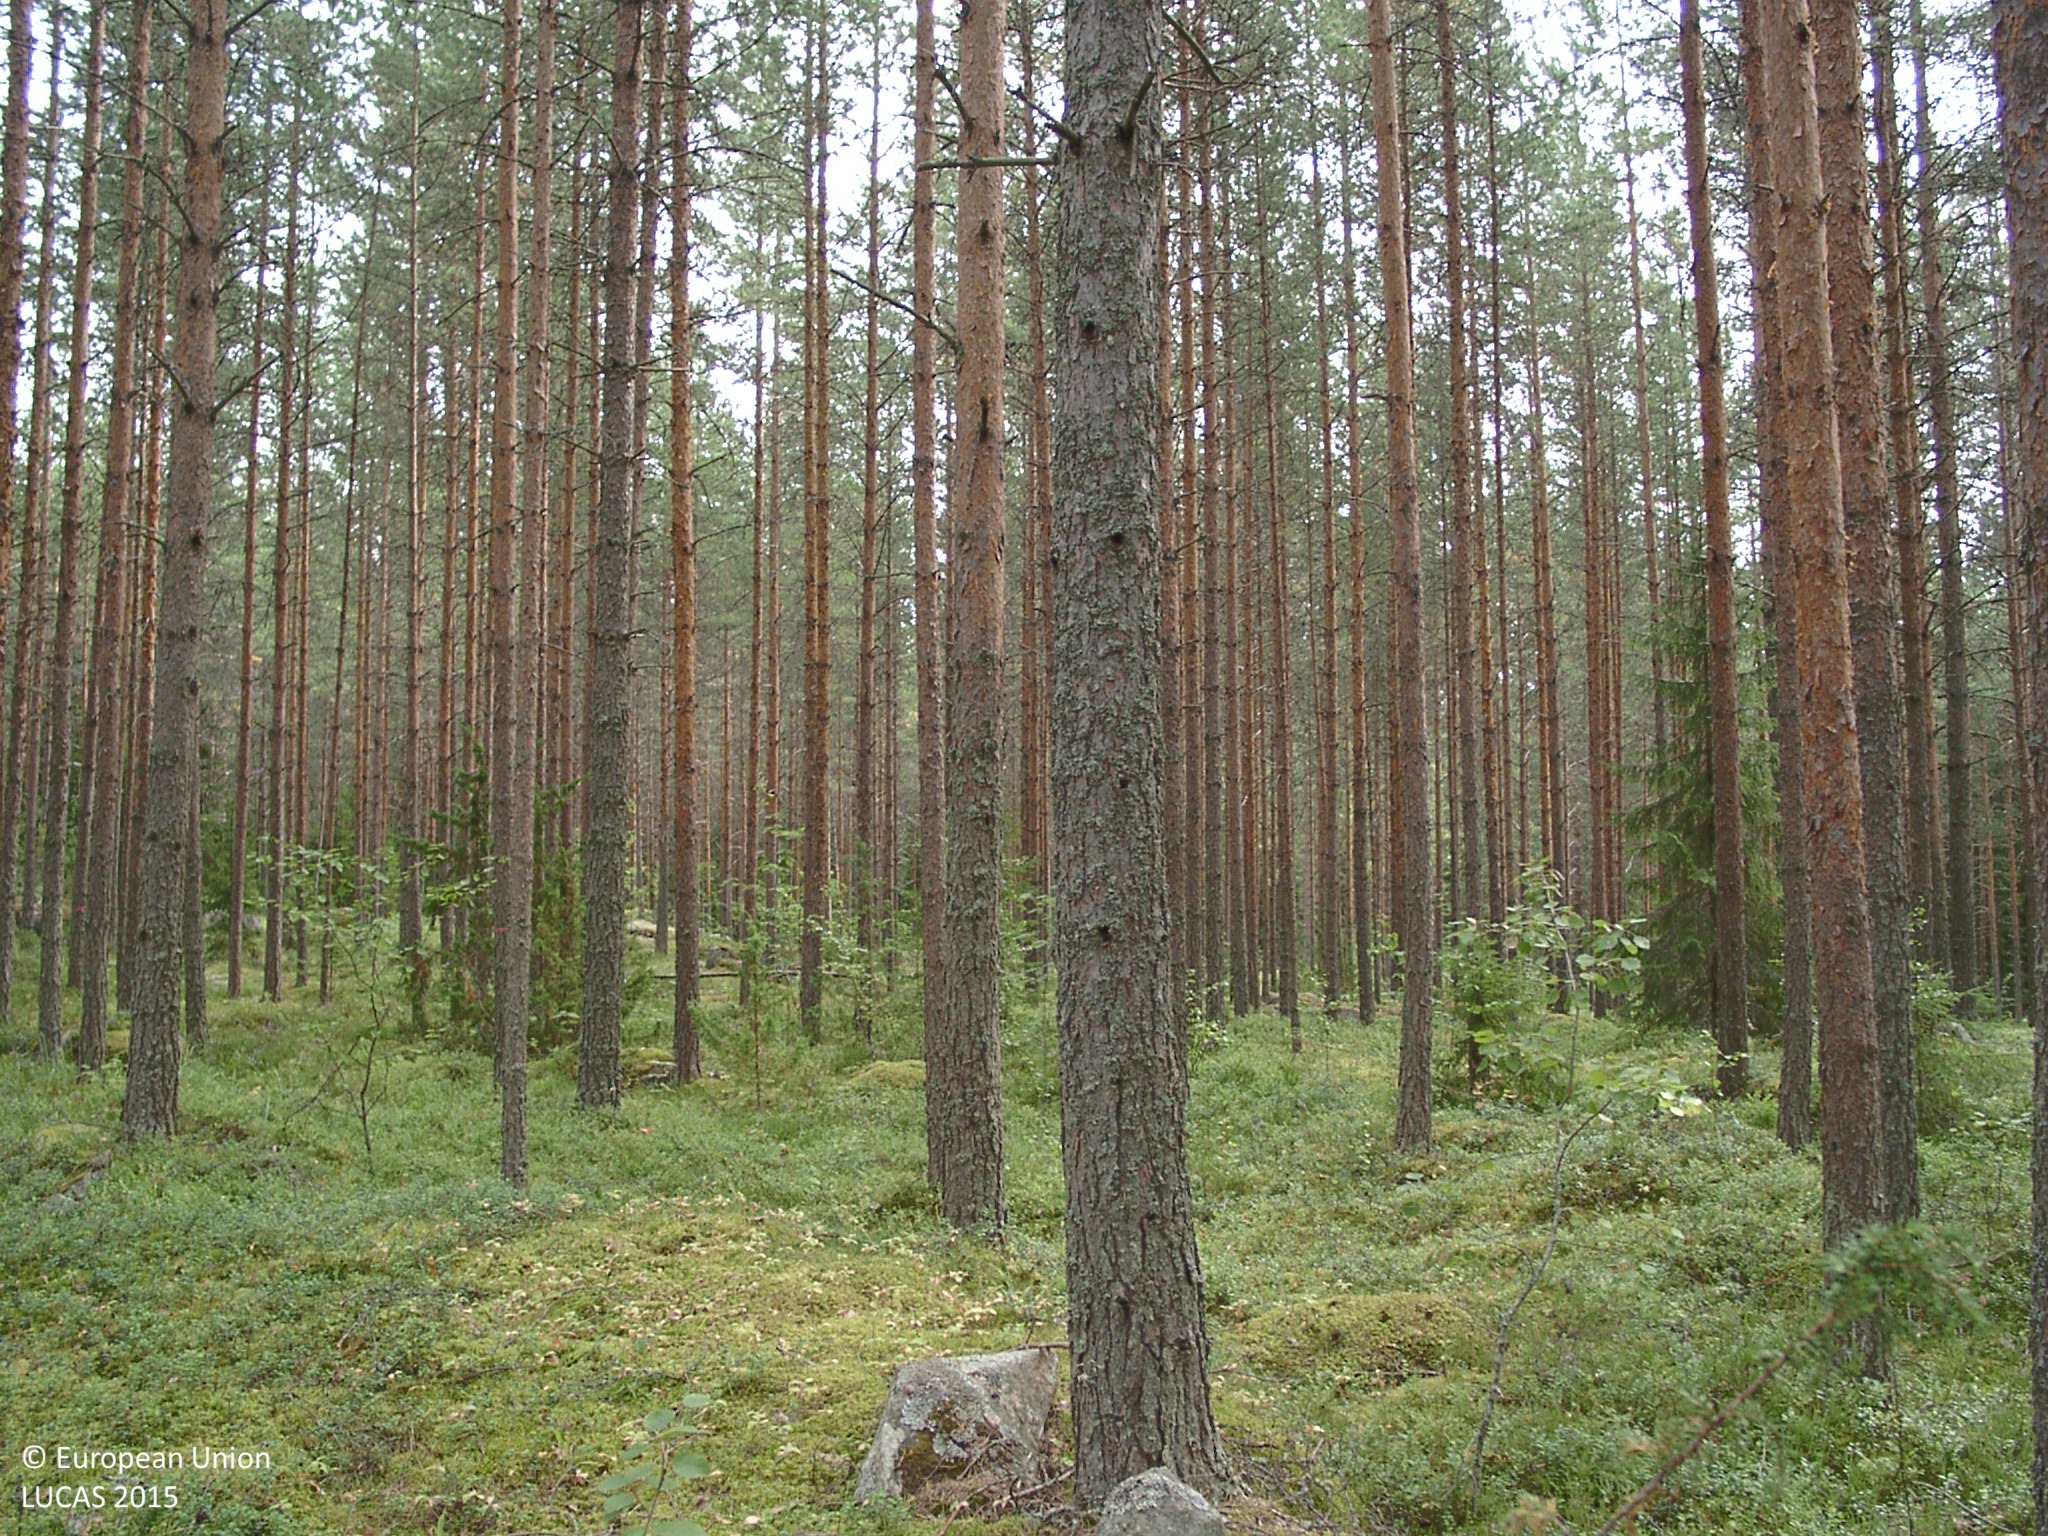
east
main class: Woodland
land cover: Pine dominated coniferous woodland
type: boreal forest
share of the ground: 50 - 75 %
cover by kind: coniferous forest trees 65 %, shrubs 20 %, lichens and mosses 10 %, broadleaved forest trees 5 %
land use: Forestry
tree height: > 5 m
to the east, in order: Pine dominated coniferous woodland; Other coniferous woodland; Electric lines; Tracks; Pine dominated coniferous woodland; Other coniferous woodland; Spruce dominated coniferous woodland; Tracks; Spruce dominated coniferous woodland; Groves; Ditches and canals; Other leguminous and mixtures for fodder
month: August
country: FI
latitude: 61.8078
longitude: 25.2735
